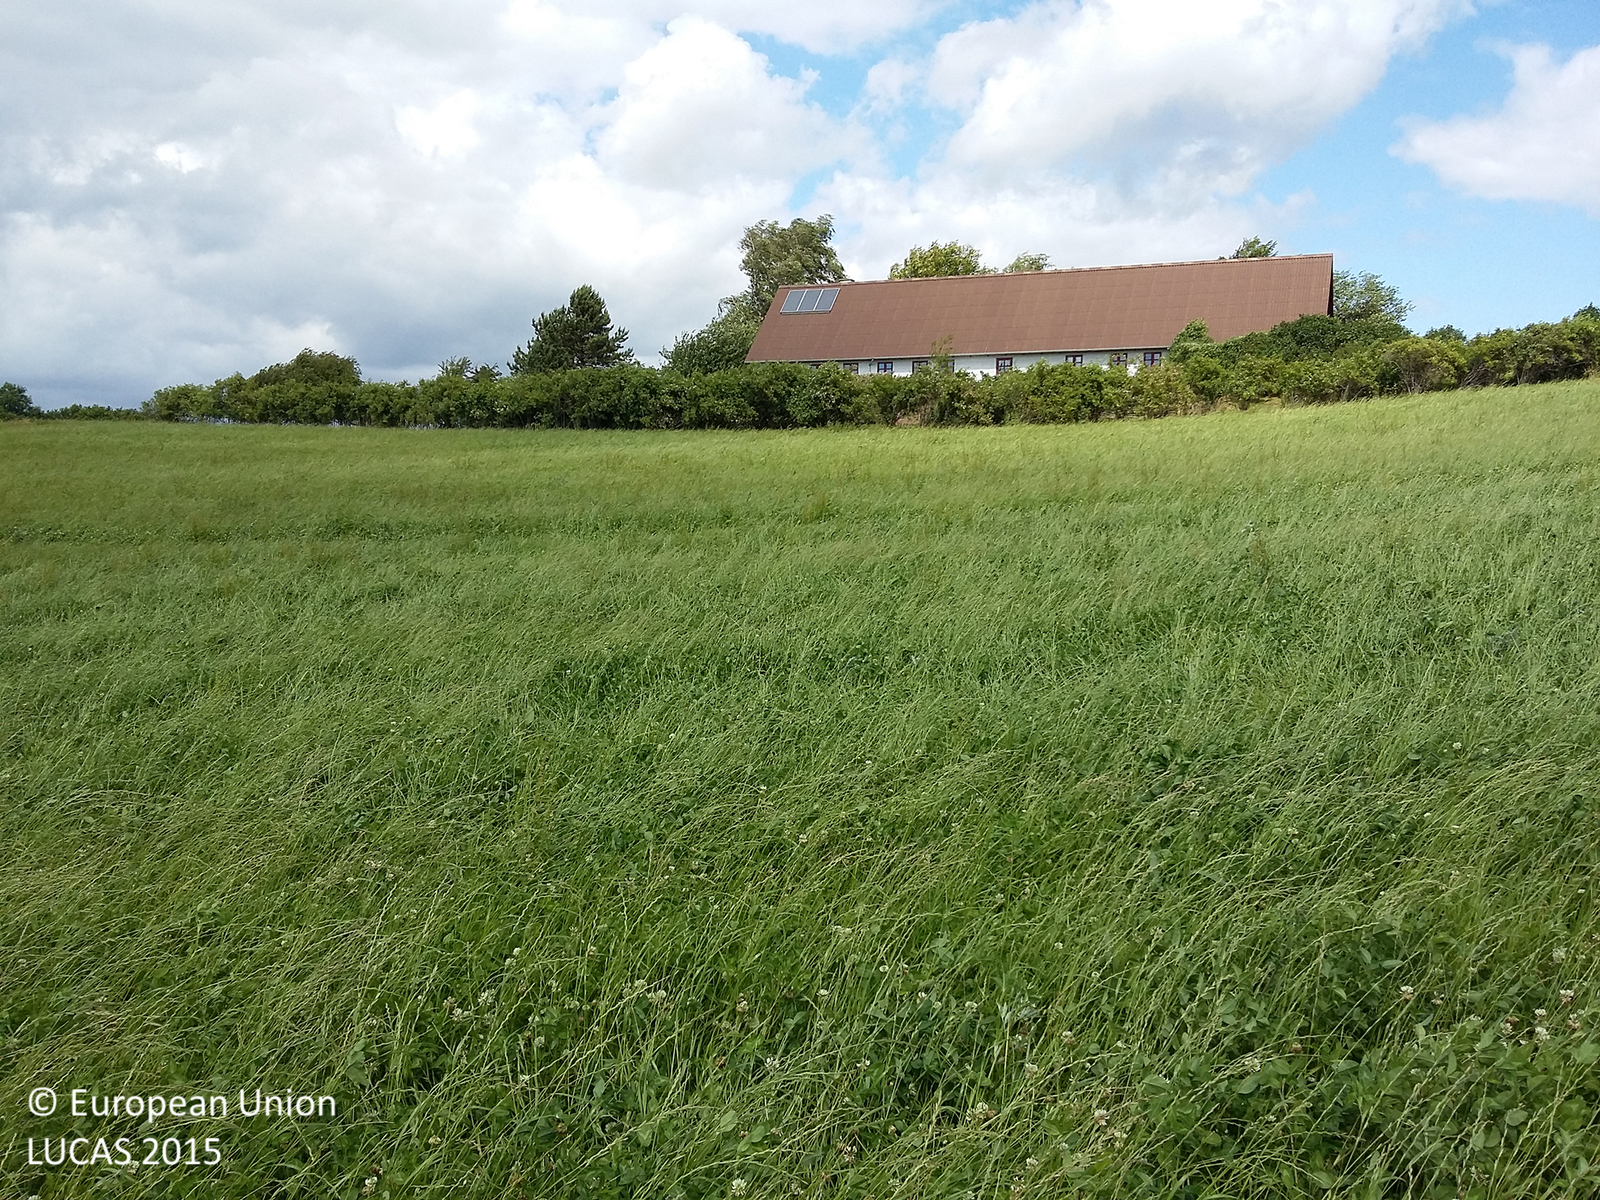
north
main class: Cropland
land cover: Clovers
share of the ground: > 75 %
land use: Agriculture (excluding fallow land and kitchen gardens)
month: July
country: DK
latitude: 55.2208
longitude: 11.9006
